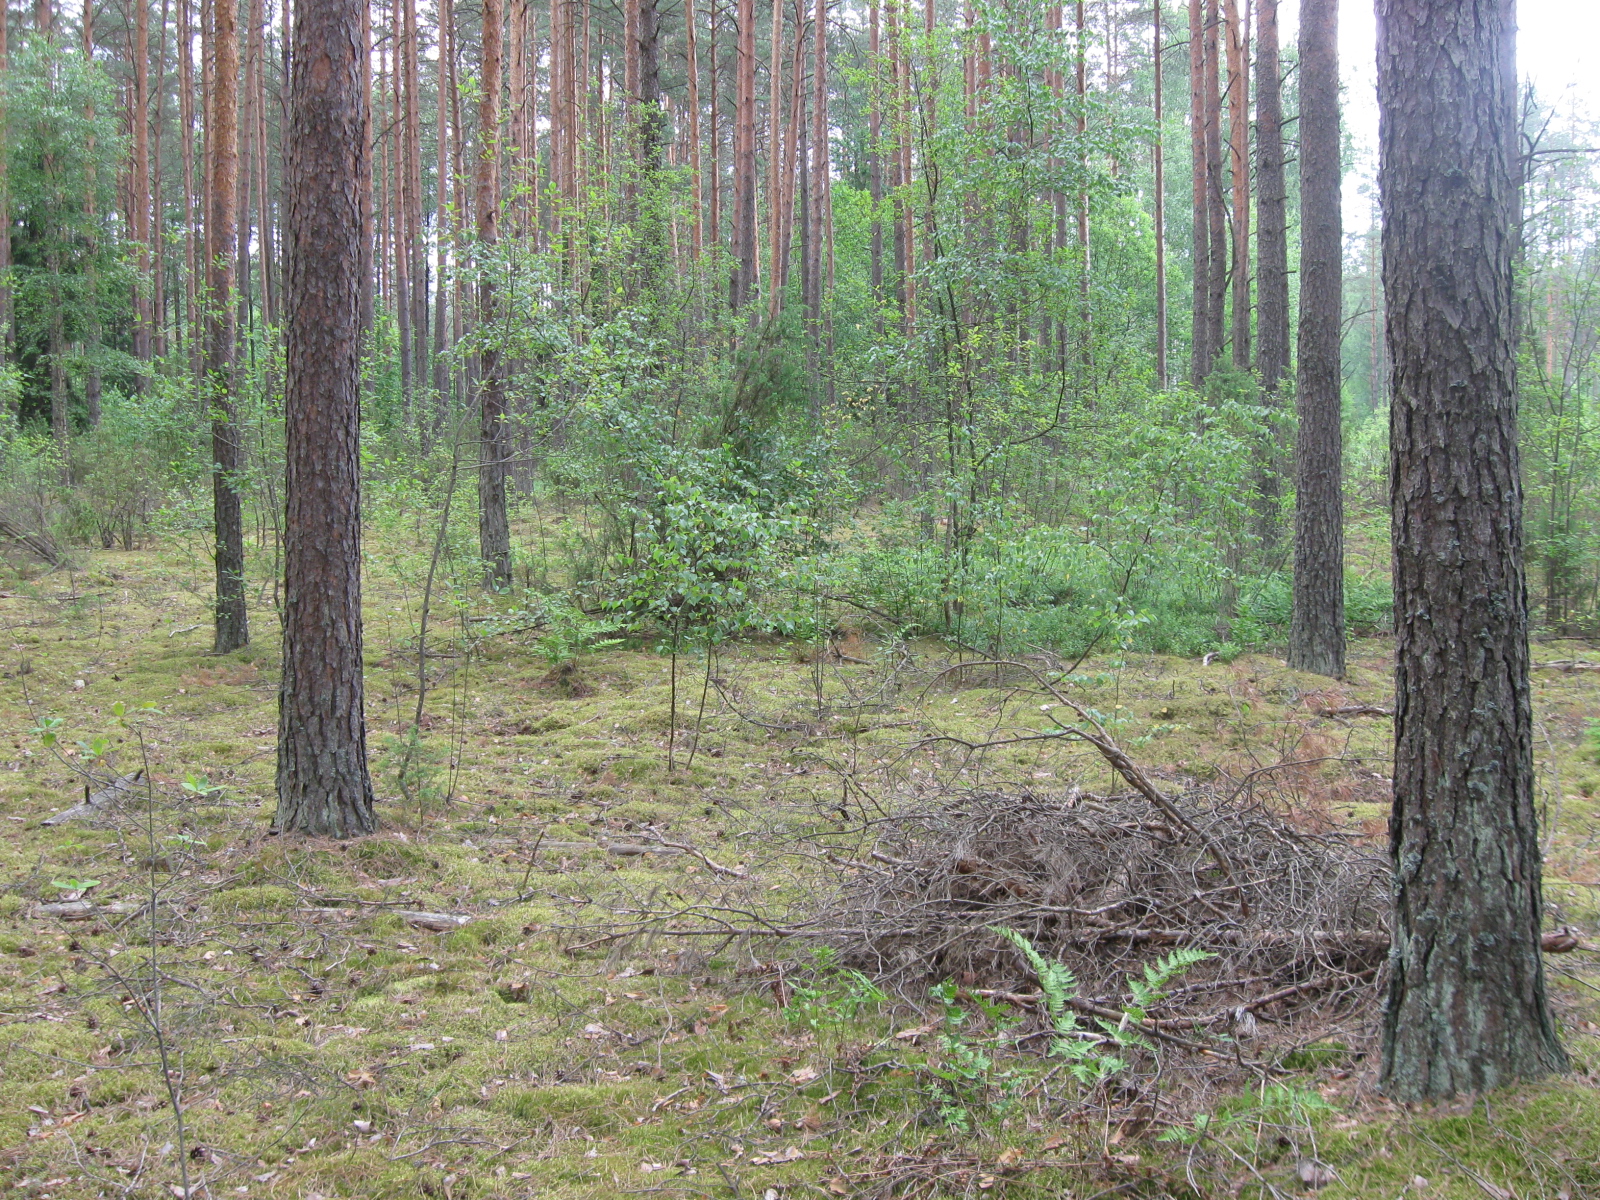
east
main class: Woodland
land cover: Pine dominated mixed woodland
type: hemiboreal forest and nemoral coniferous forest and mixed broadleaved-coniferous forest
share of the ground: > 75 %
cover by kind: coniferous forest trees 45 %, broadleaved forest trees 30 %, lichens and mosses 25 %
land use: Forestry
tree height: > 5 m
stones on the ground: < 10 %
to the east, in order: Pine dominated mixed woodland; Broadleaved woodland; Pine dominated mixed woodland
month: July
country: LT
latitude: 54.1915
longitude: 24.3067
